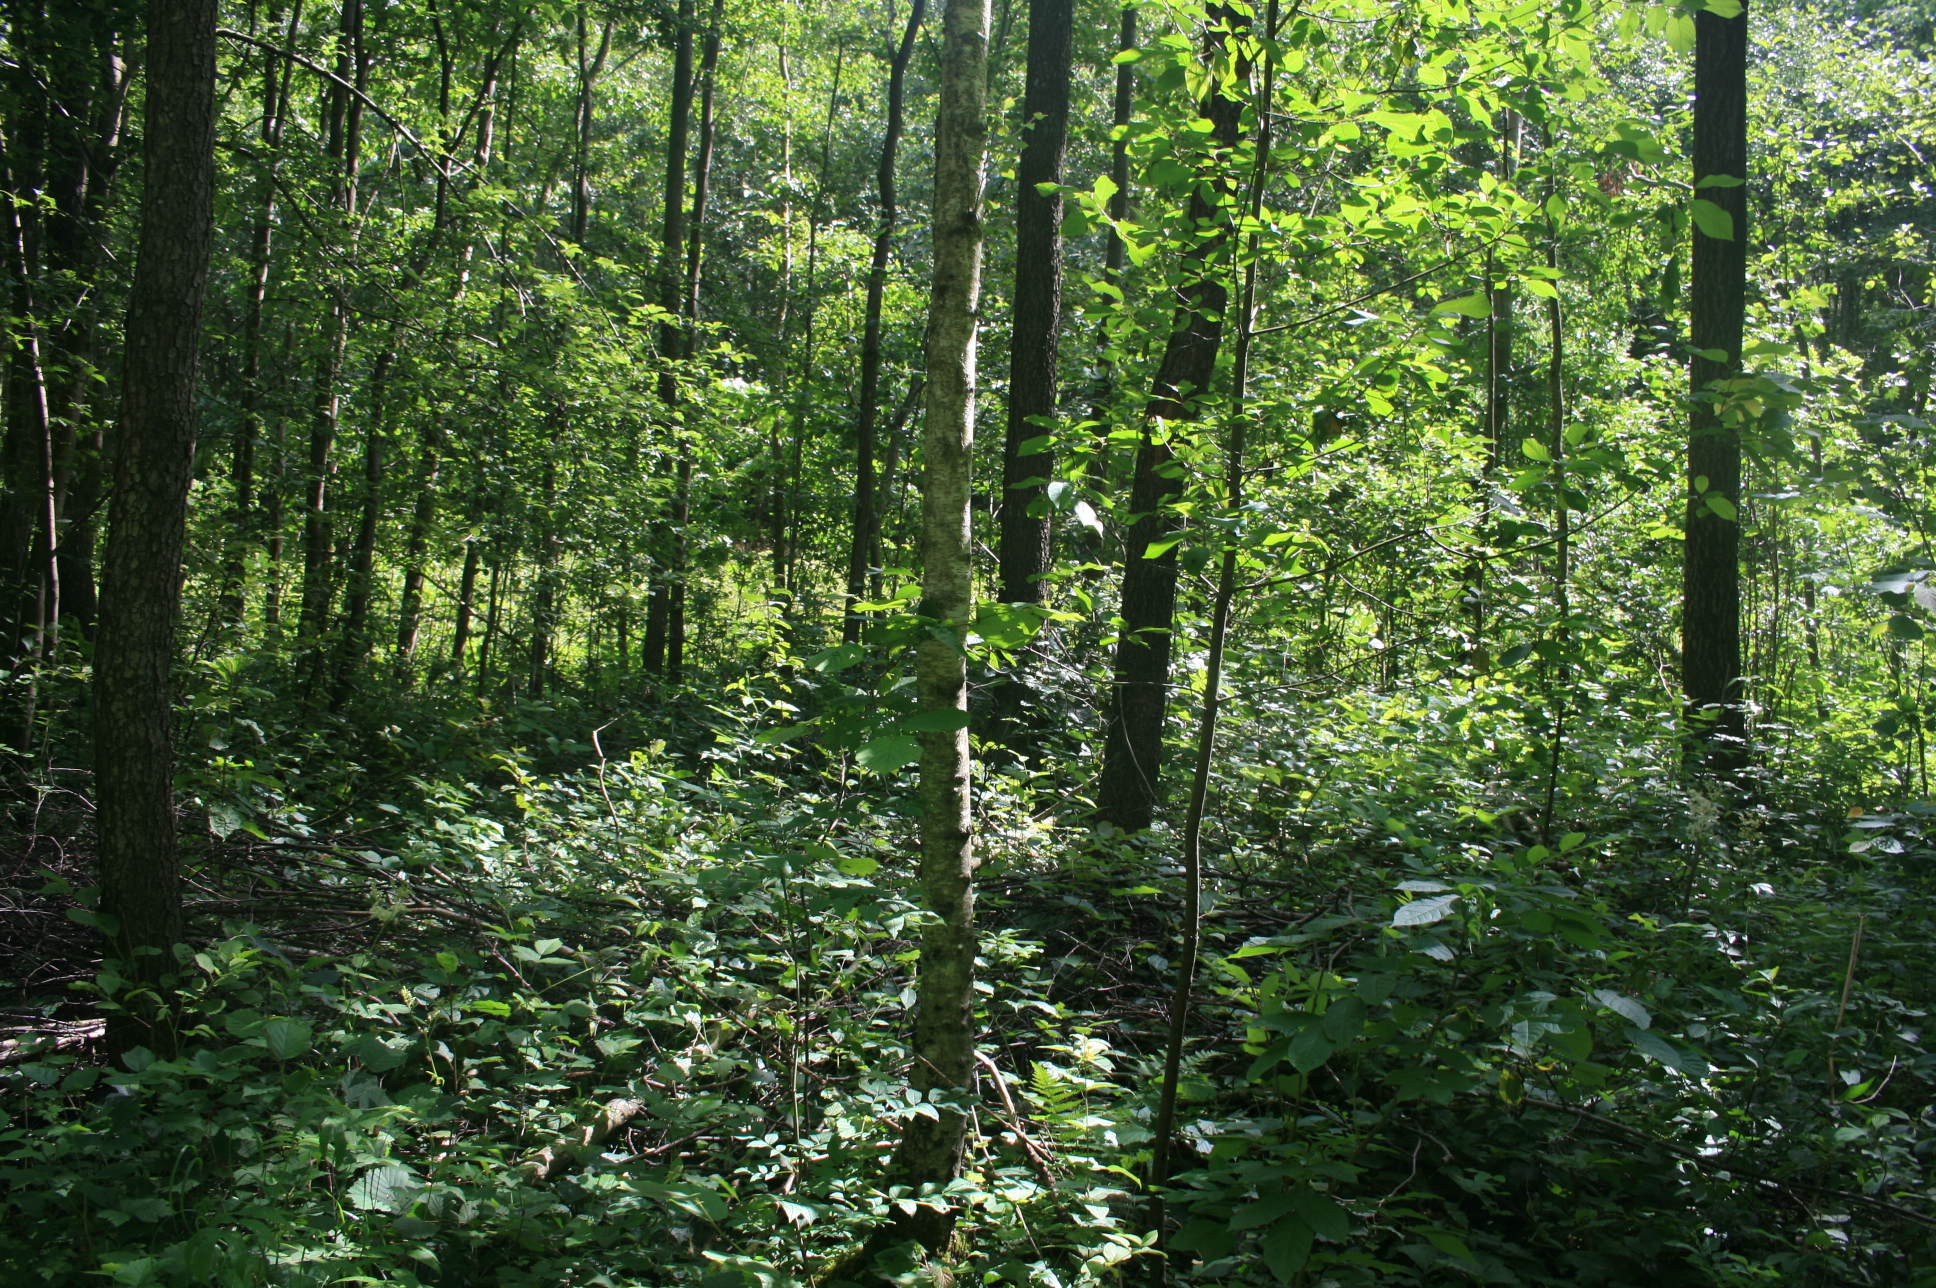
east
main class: Woodland
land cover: Broadleaved woodland
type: non-riverine alder, birch or aspen forest
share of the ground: > 75 %
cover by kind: broadleaved forest trees 90 %, shrubs 5 %, herbaceous plants 5 %
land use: Forestry
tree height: > 5 m
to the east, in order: Broadleaved woodland; Spontaneously vegetated surfaces; Paved roads, cycling and walking lanes; Spontaneously vegetated surfaces; Broadleaved woodland
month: July
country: LT
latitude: 55.7857
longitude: 21.4135
